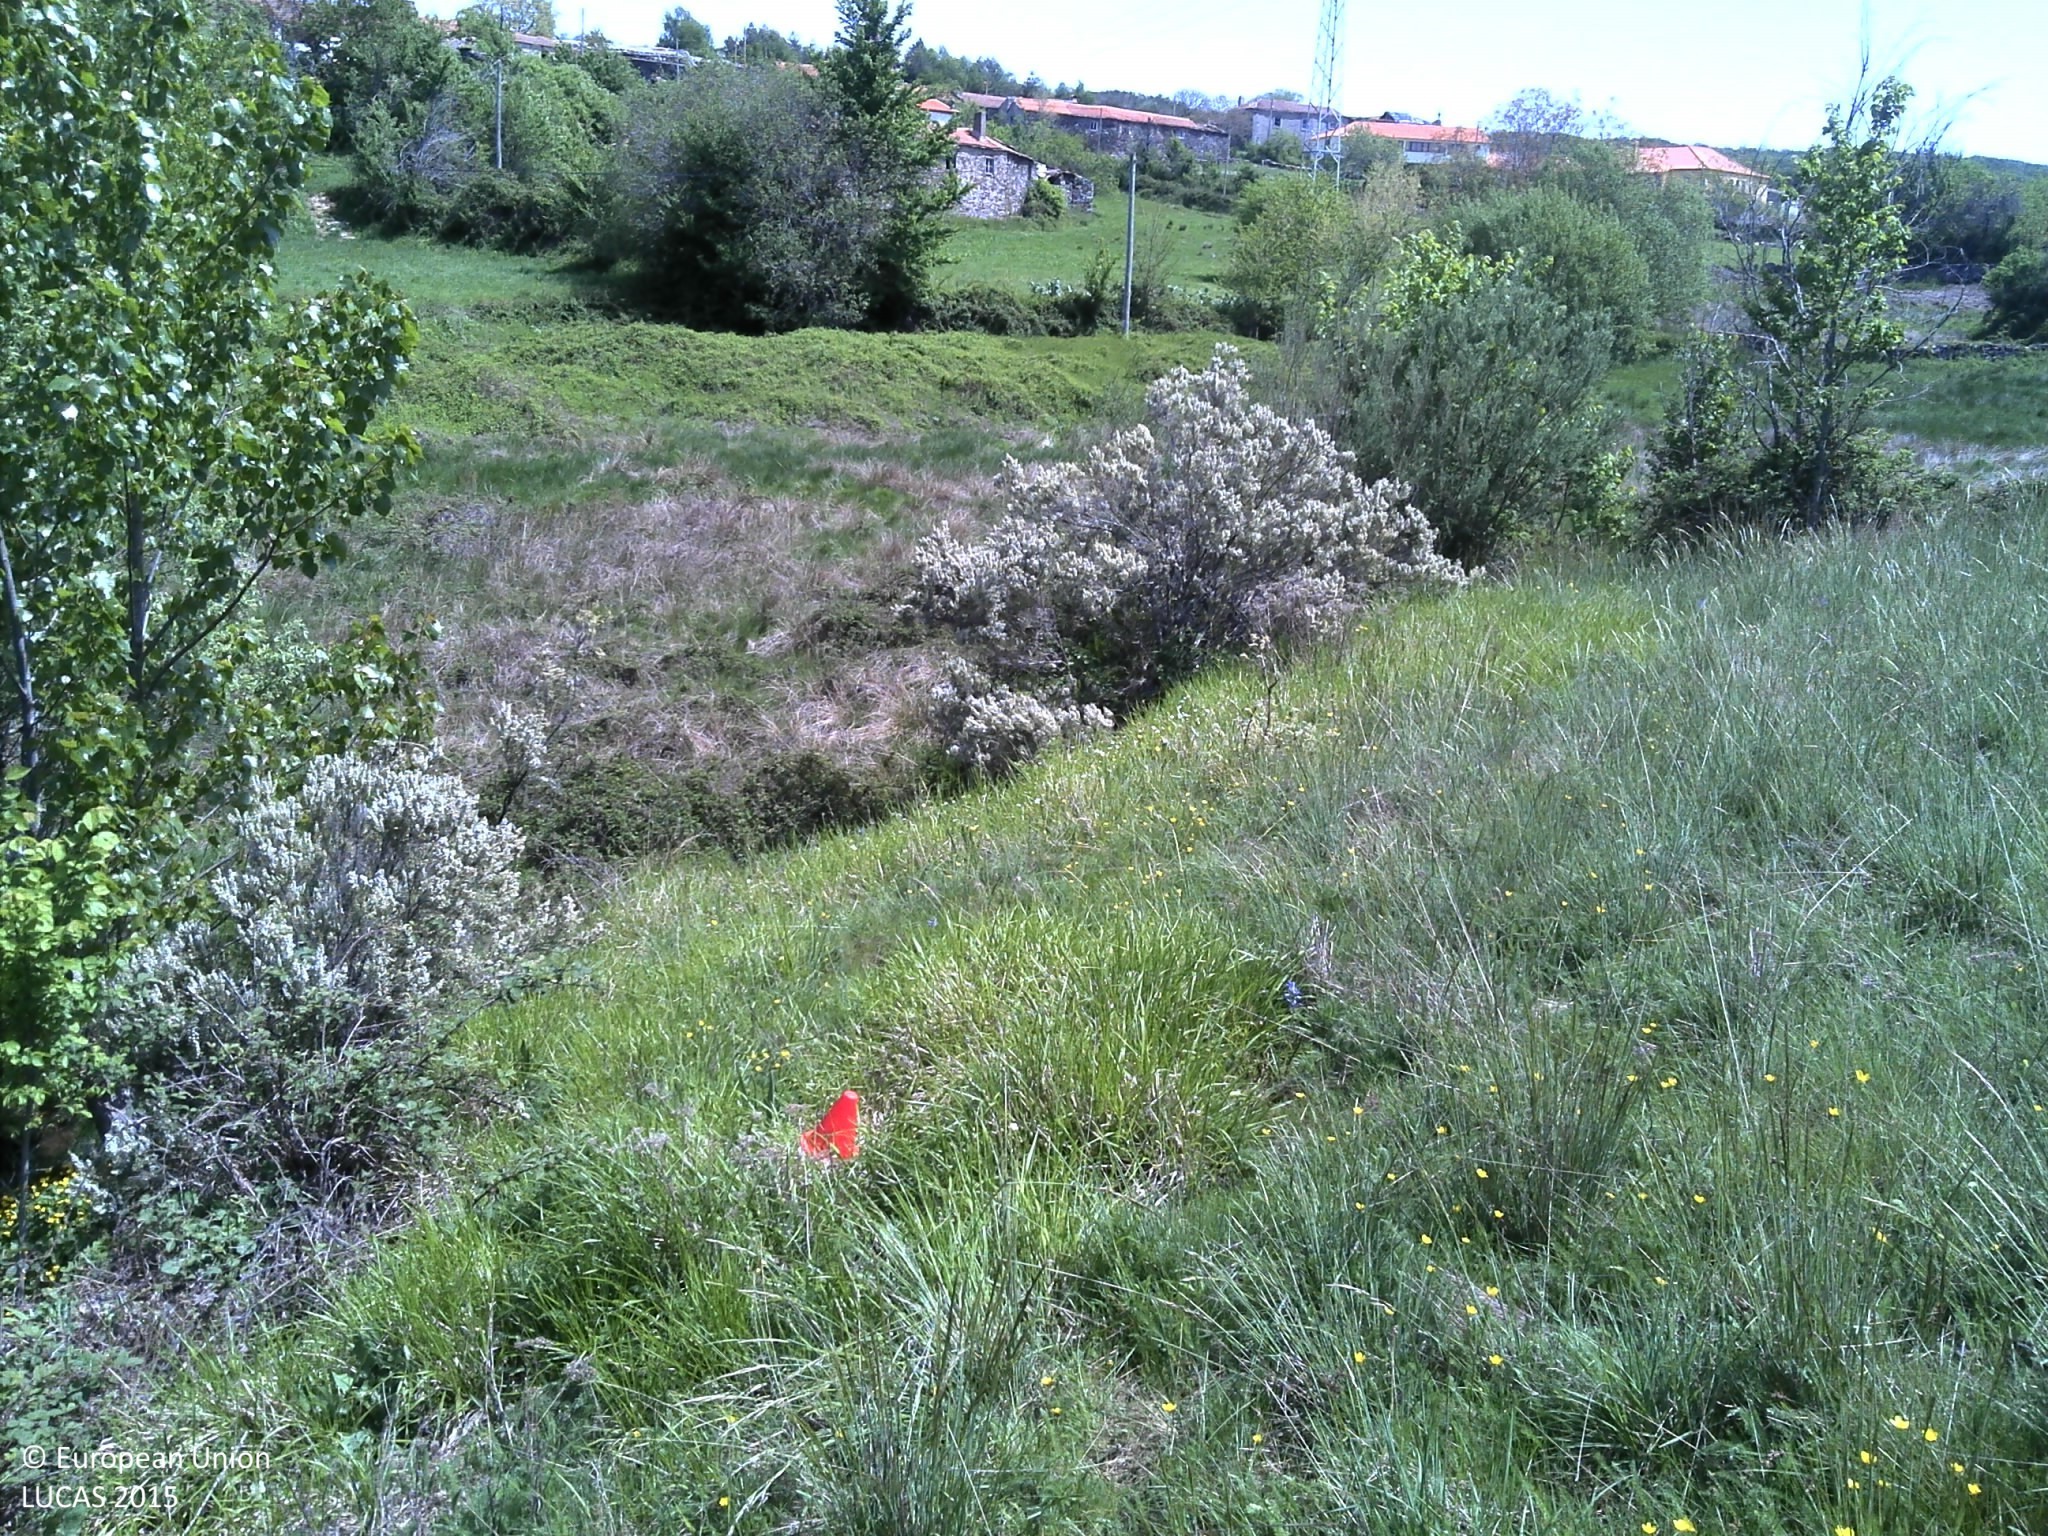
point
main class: Grassland
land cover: Grassland with sparse tree/shrub cover
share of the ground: > 75 %
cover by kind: herbaceous plants 95 %, broadleaved forest trees 5 %
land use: Agriculture (excluding fallow land and kitchen gardens)
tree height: > 5 m
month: May
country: PT
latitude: 41.9203
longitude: -7.0140
